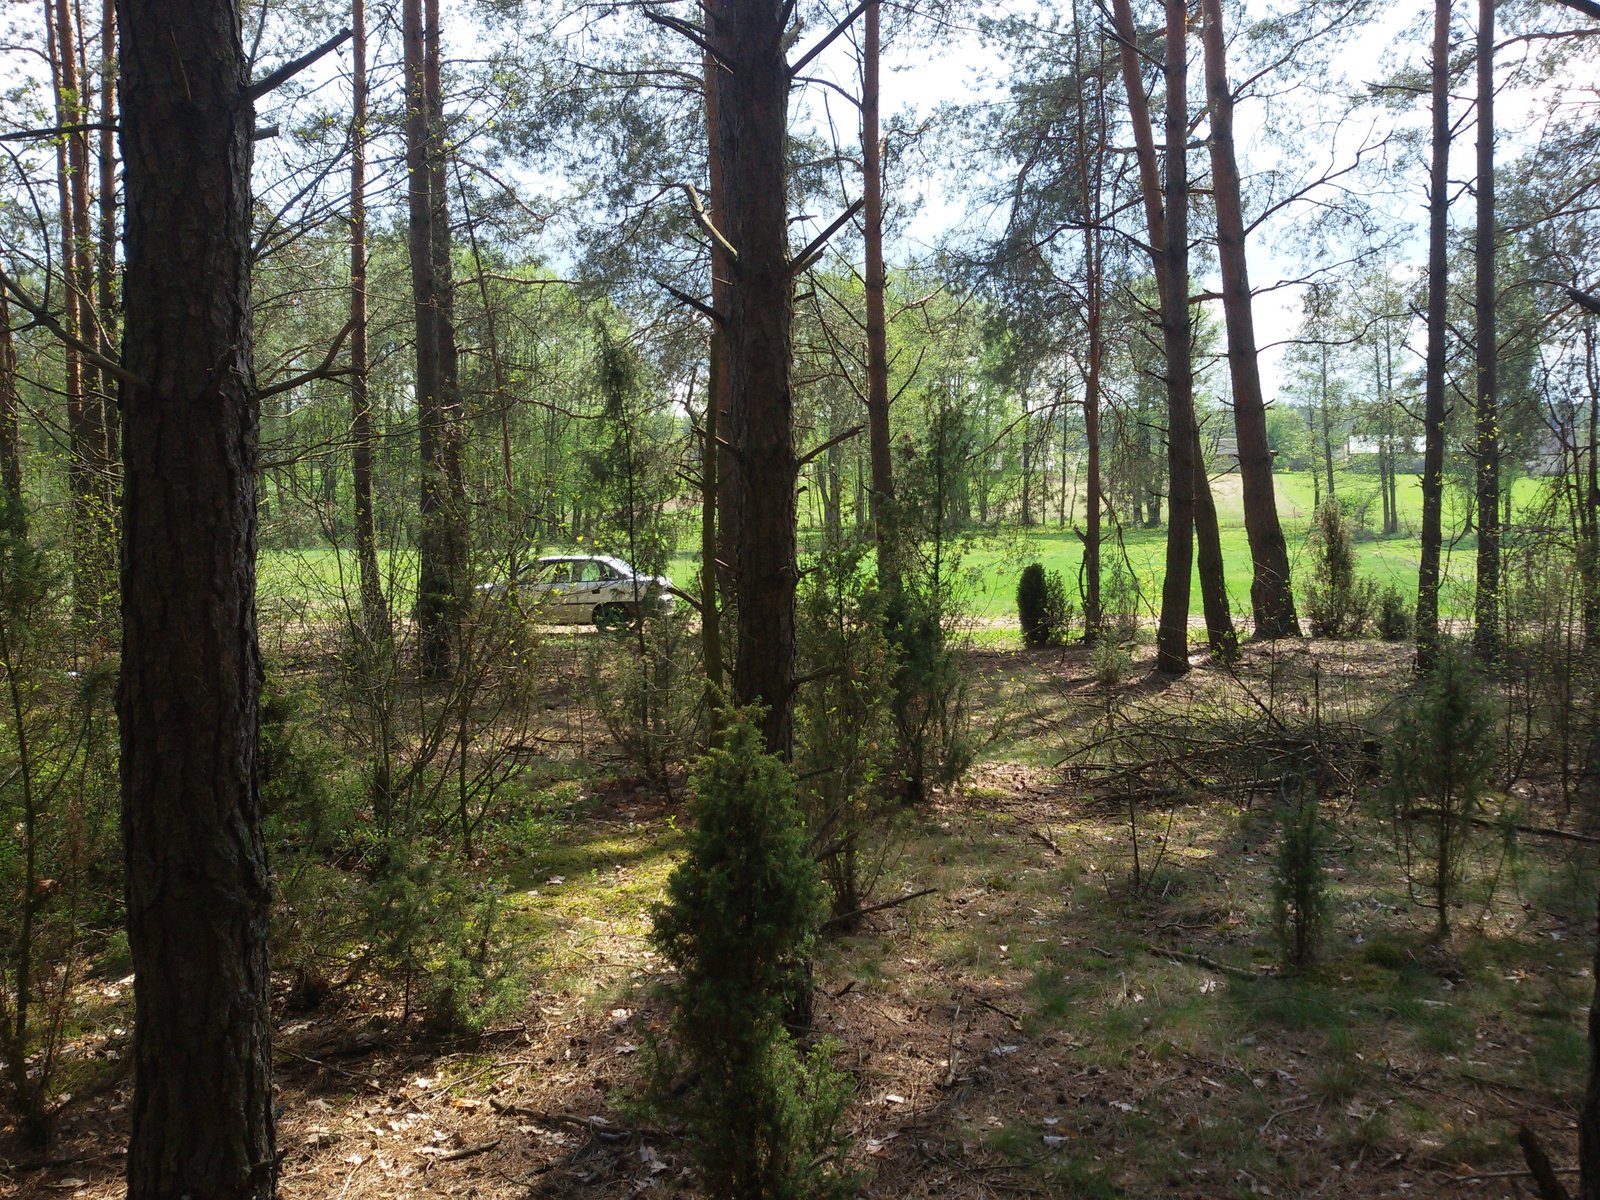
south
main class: Woodland
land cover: Pine dominated coniferous woodland
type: hemiboreal forest and nemoral coniferous forest and mixed broadleaved-coniferous forest
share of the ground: > 75 %
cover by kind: coniferous forest trees 75 %, lichens and mosses 15 %, shrubs 5 %, herbaceous plants 5 %
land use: Forestry
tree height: > 5 m
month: May
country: PL
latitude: 53.0525
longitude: 22.4021
